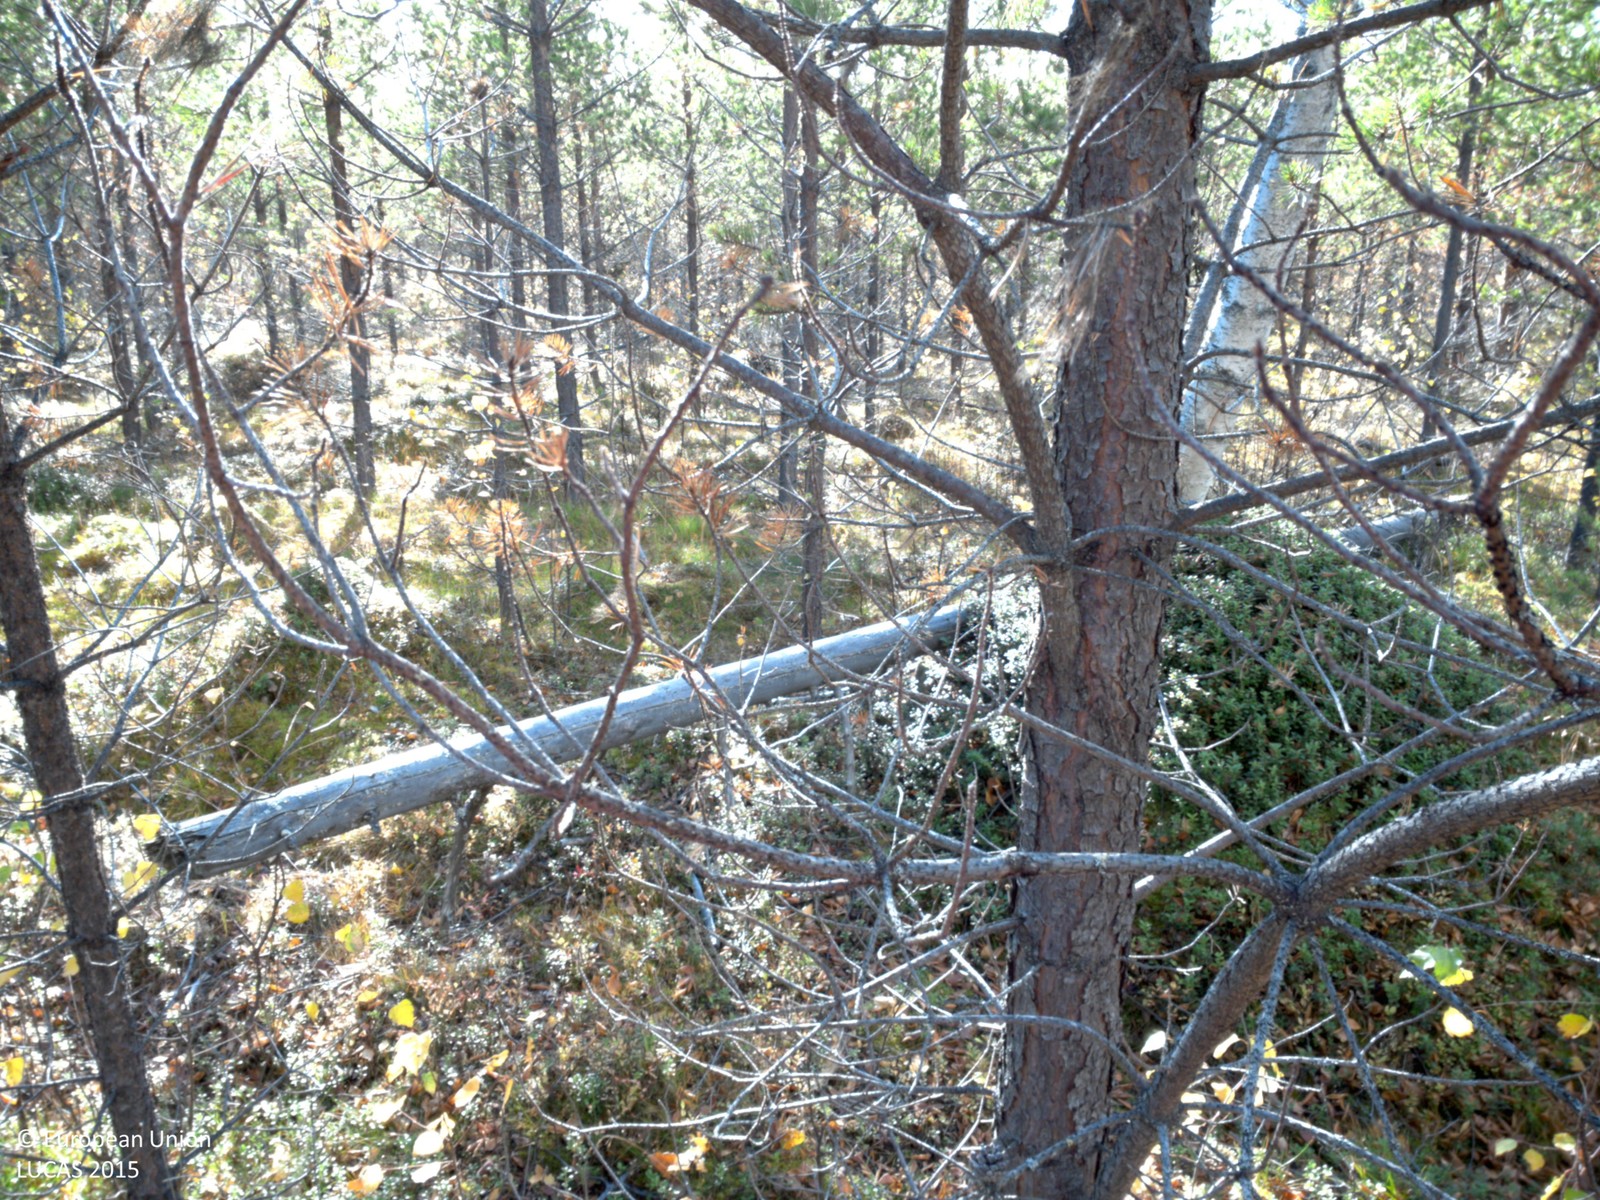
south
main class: Woodland
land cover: Pine dominated coniferous woodland
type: boreal forest
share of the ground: > 75 %
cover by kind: coniferous forest trees 75 %, shrubs 10 %, broadleaved forest trees 5 %, herbaceous plants 5 %, lichens and mosses 5 %
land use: Forestry
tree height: < 5 m
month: October
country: SE
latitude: 64.8893
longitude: 18.3070
